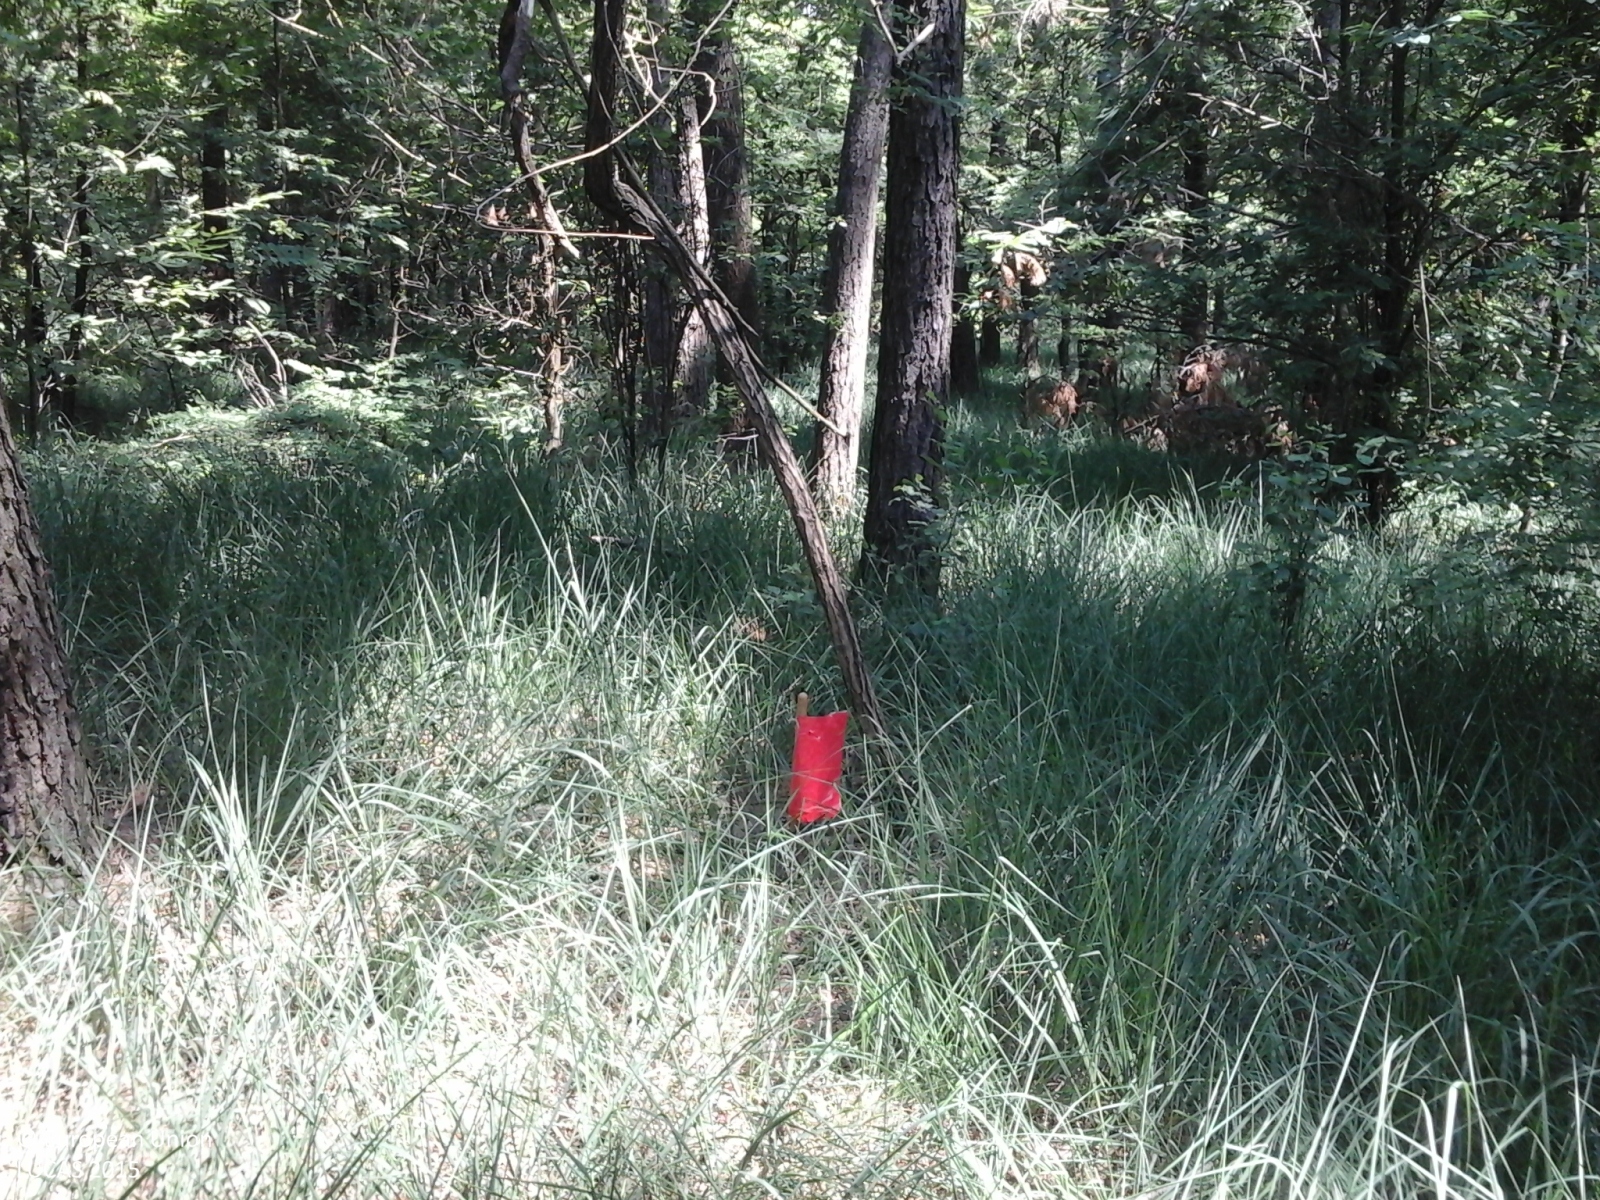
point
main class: Woodland
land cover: Pine dominated mixed woodland
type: thermophilous deciduous forest
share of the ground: > 75 %
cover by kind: coniferous forest trees 75 %, broadleaved forest trees 25 %
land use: Forestry
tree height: > 5 m
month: June
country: IT
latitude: 45.6587
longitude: 8.7059
